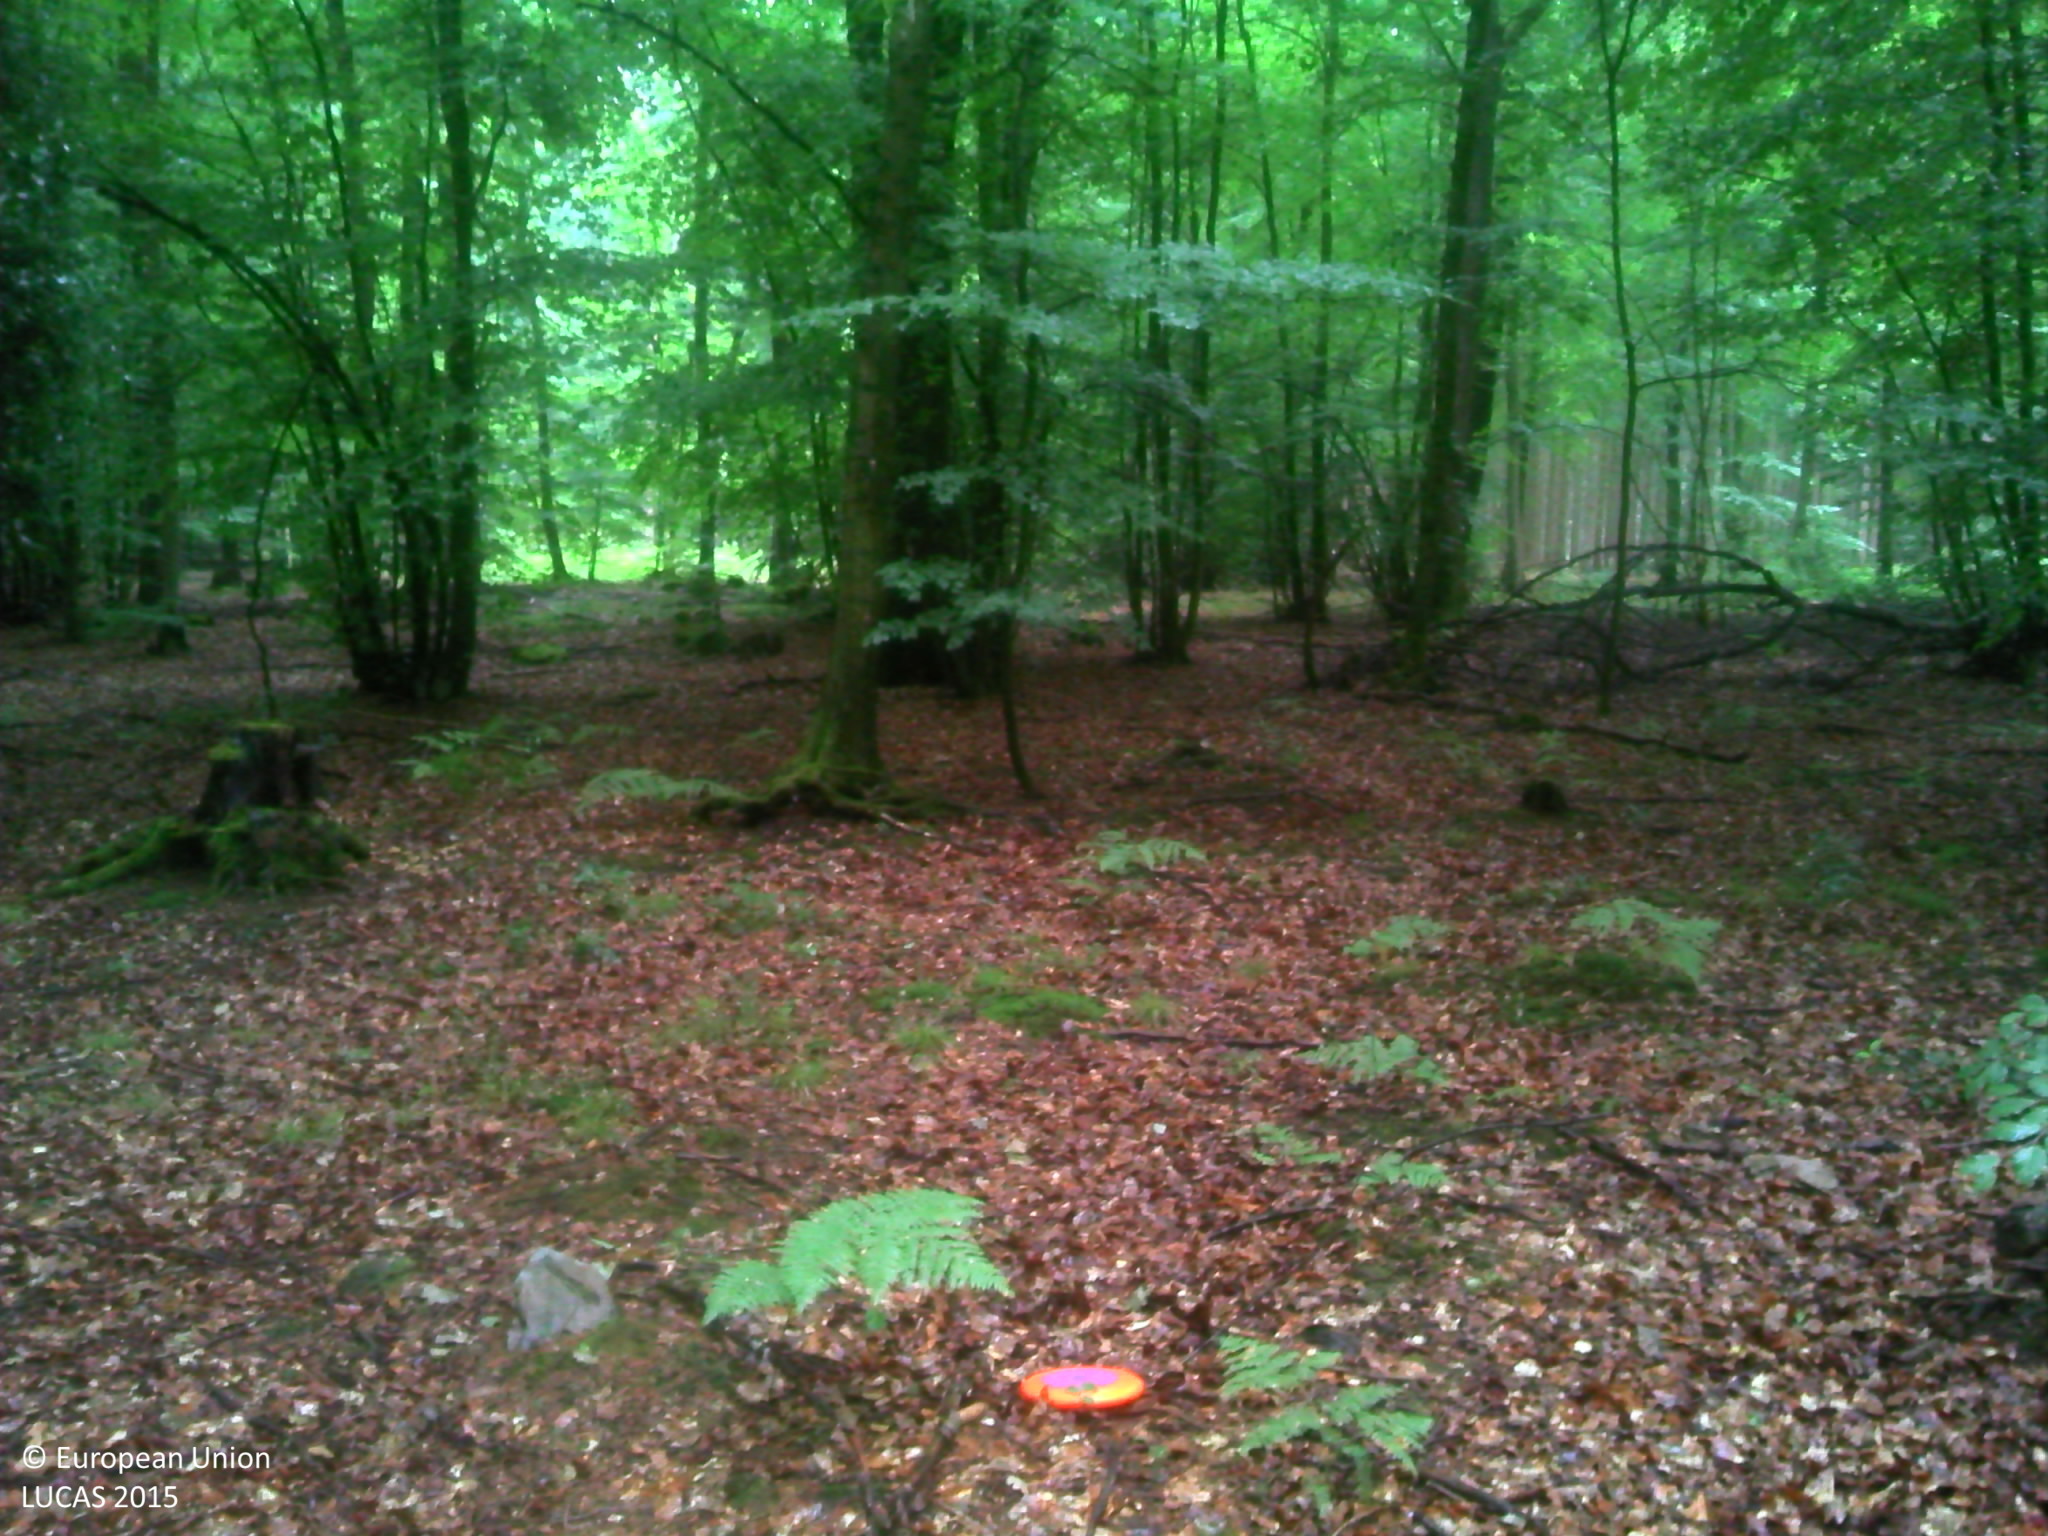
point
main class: Woodland
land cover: Broadleaved woodland
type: acidophilous oak and oak-birch forest
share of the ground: > 75 %
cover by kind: broadleaved forest trees 100 %
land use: Forestry
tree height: > 5 m
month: July
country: BE
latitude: 50.0419
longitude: 4.6765
